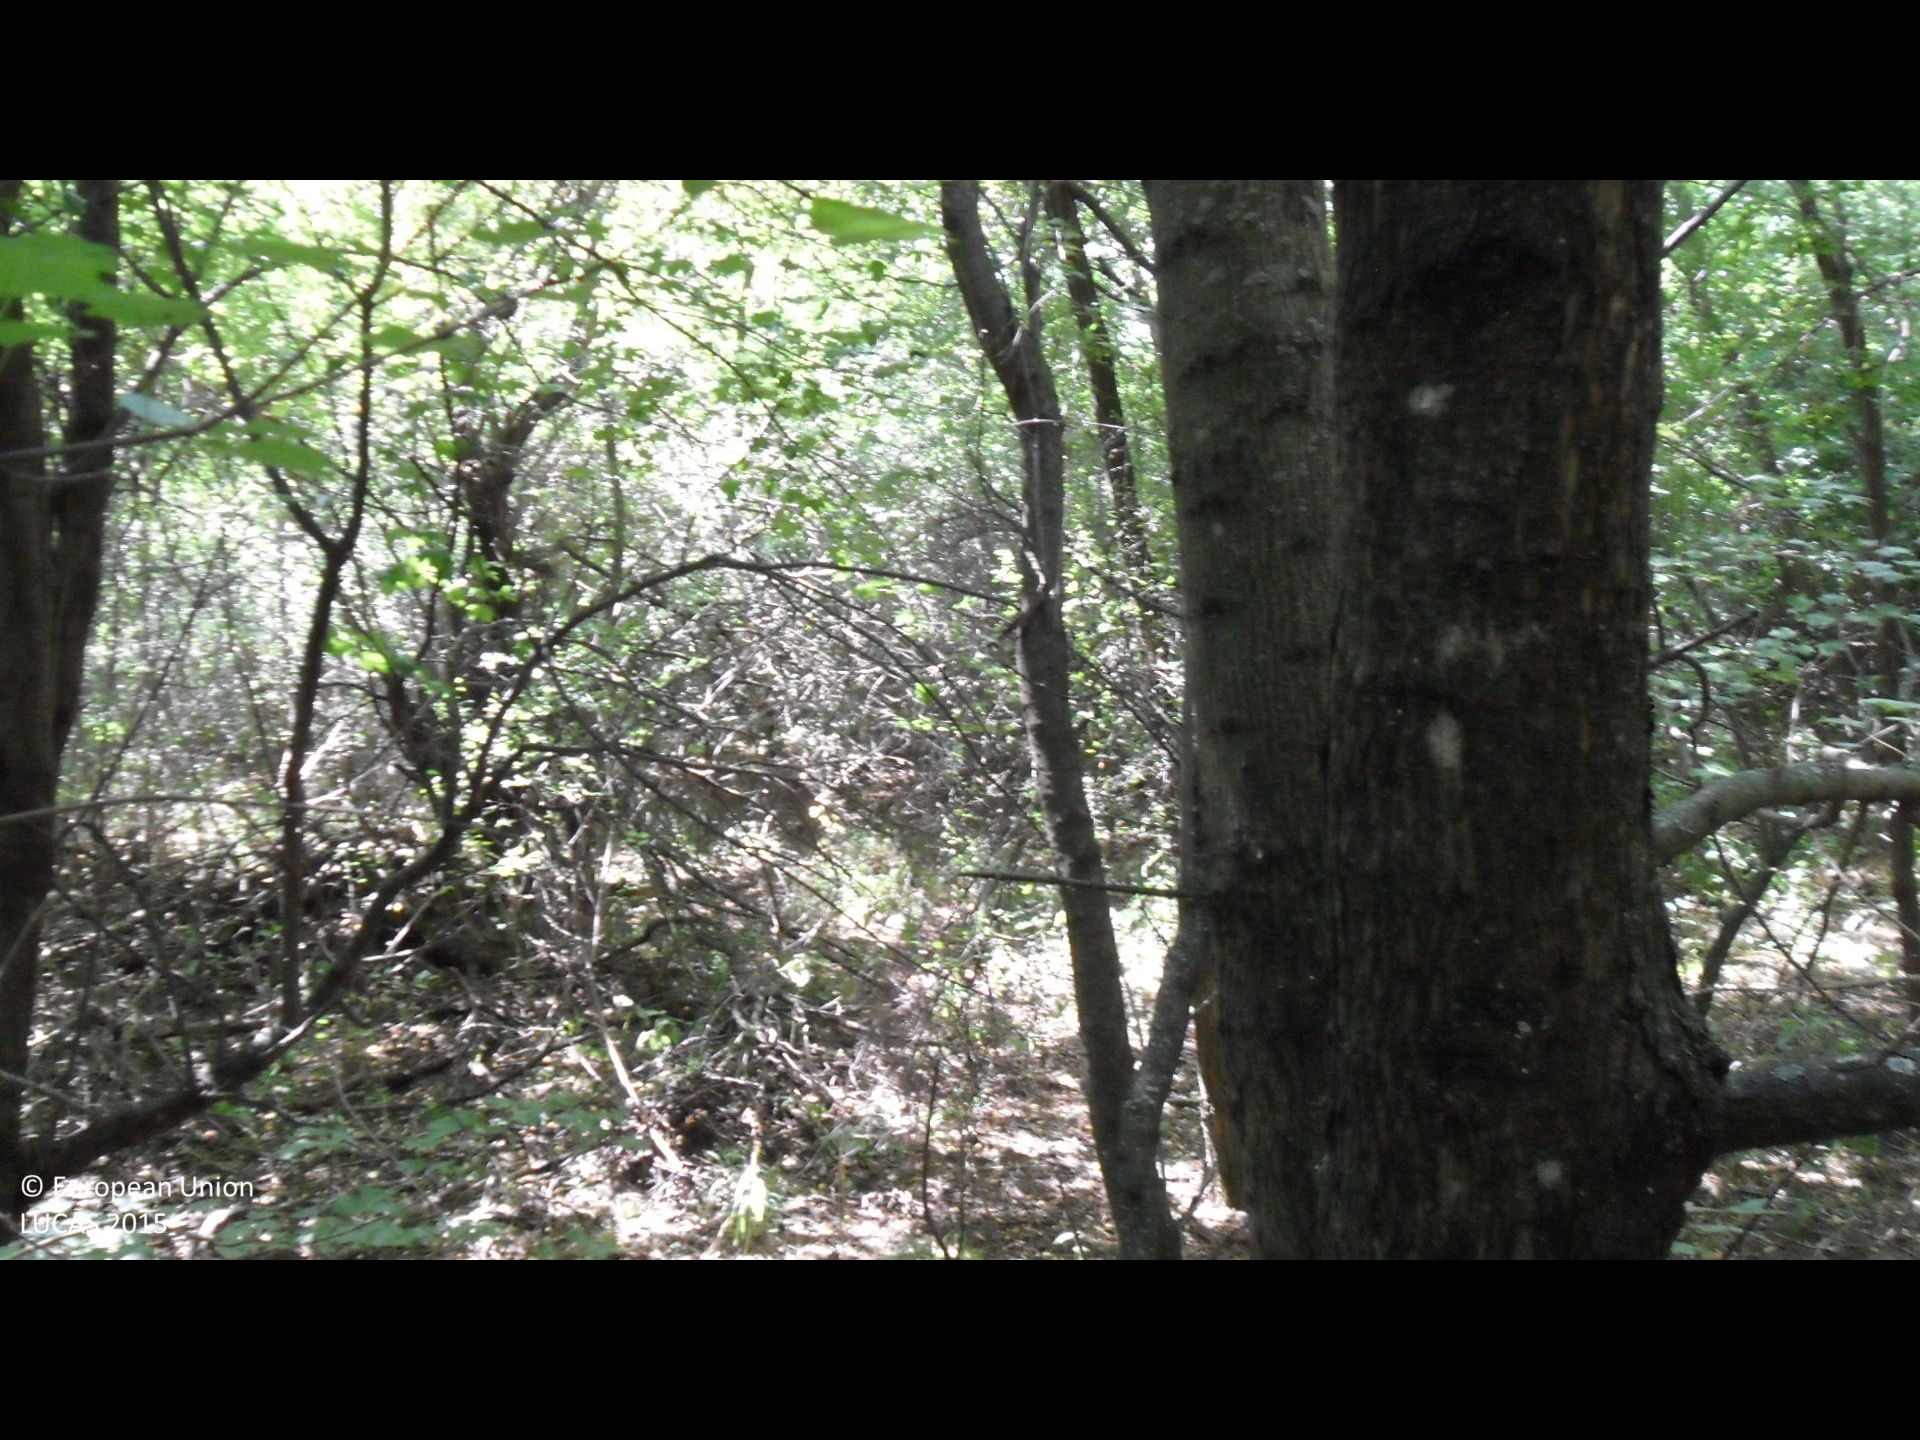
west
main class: Woodland
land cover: Broadleaved woodland
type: mesophytic deciduous forest
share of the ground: > 75 %
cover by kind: broadleaved forest trees 90 %, shrubs 10 %
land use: Forestry
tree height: > 5 m
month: August
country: BG
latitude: 43.3126
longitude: 26.1595
